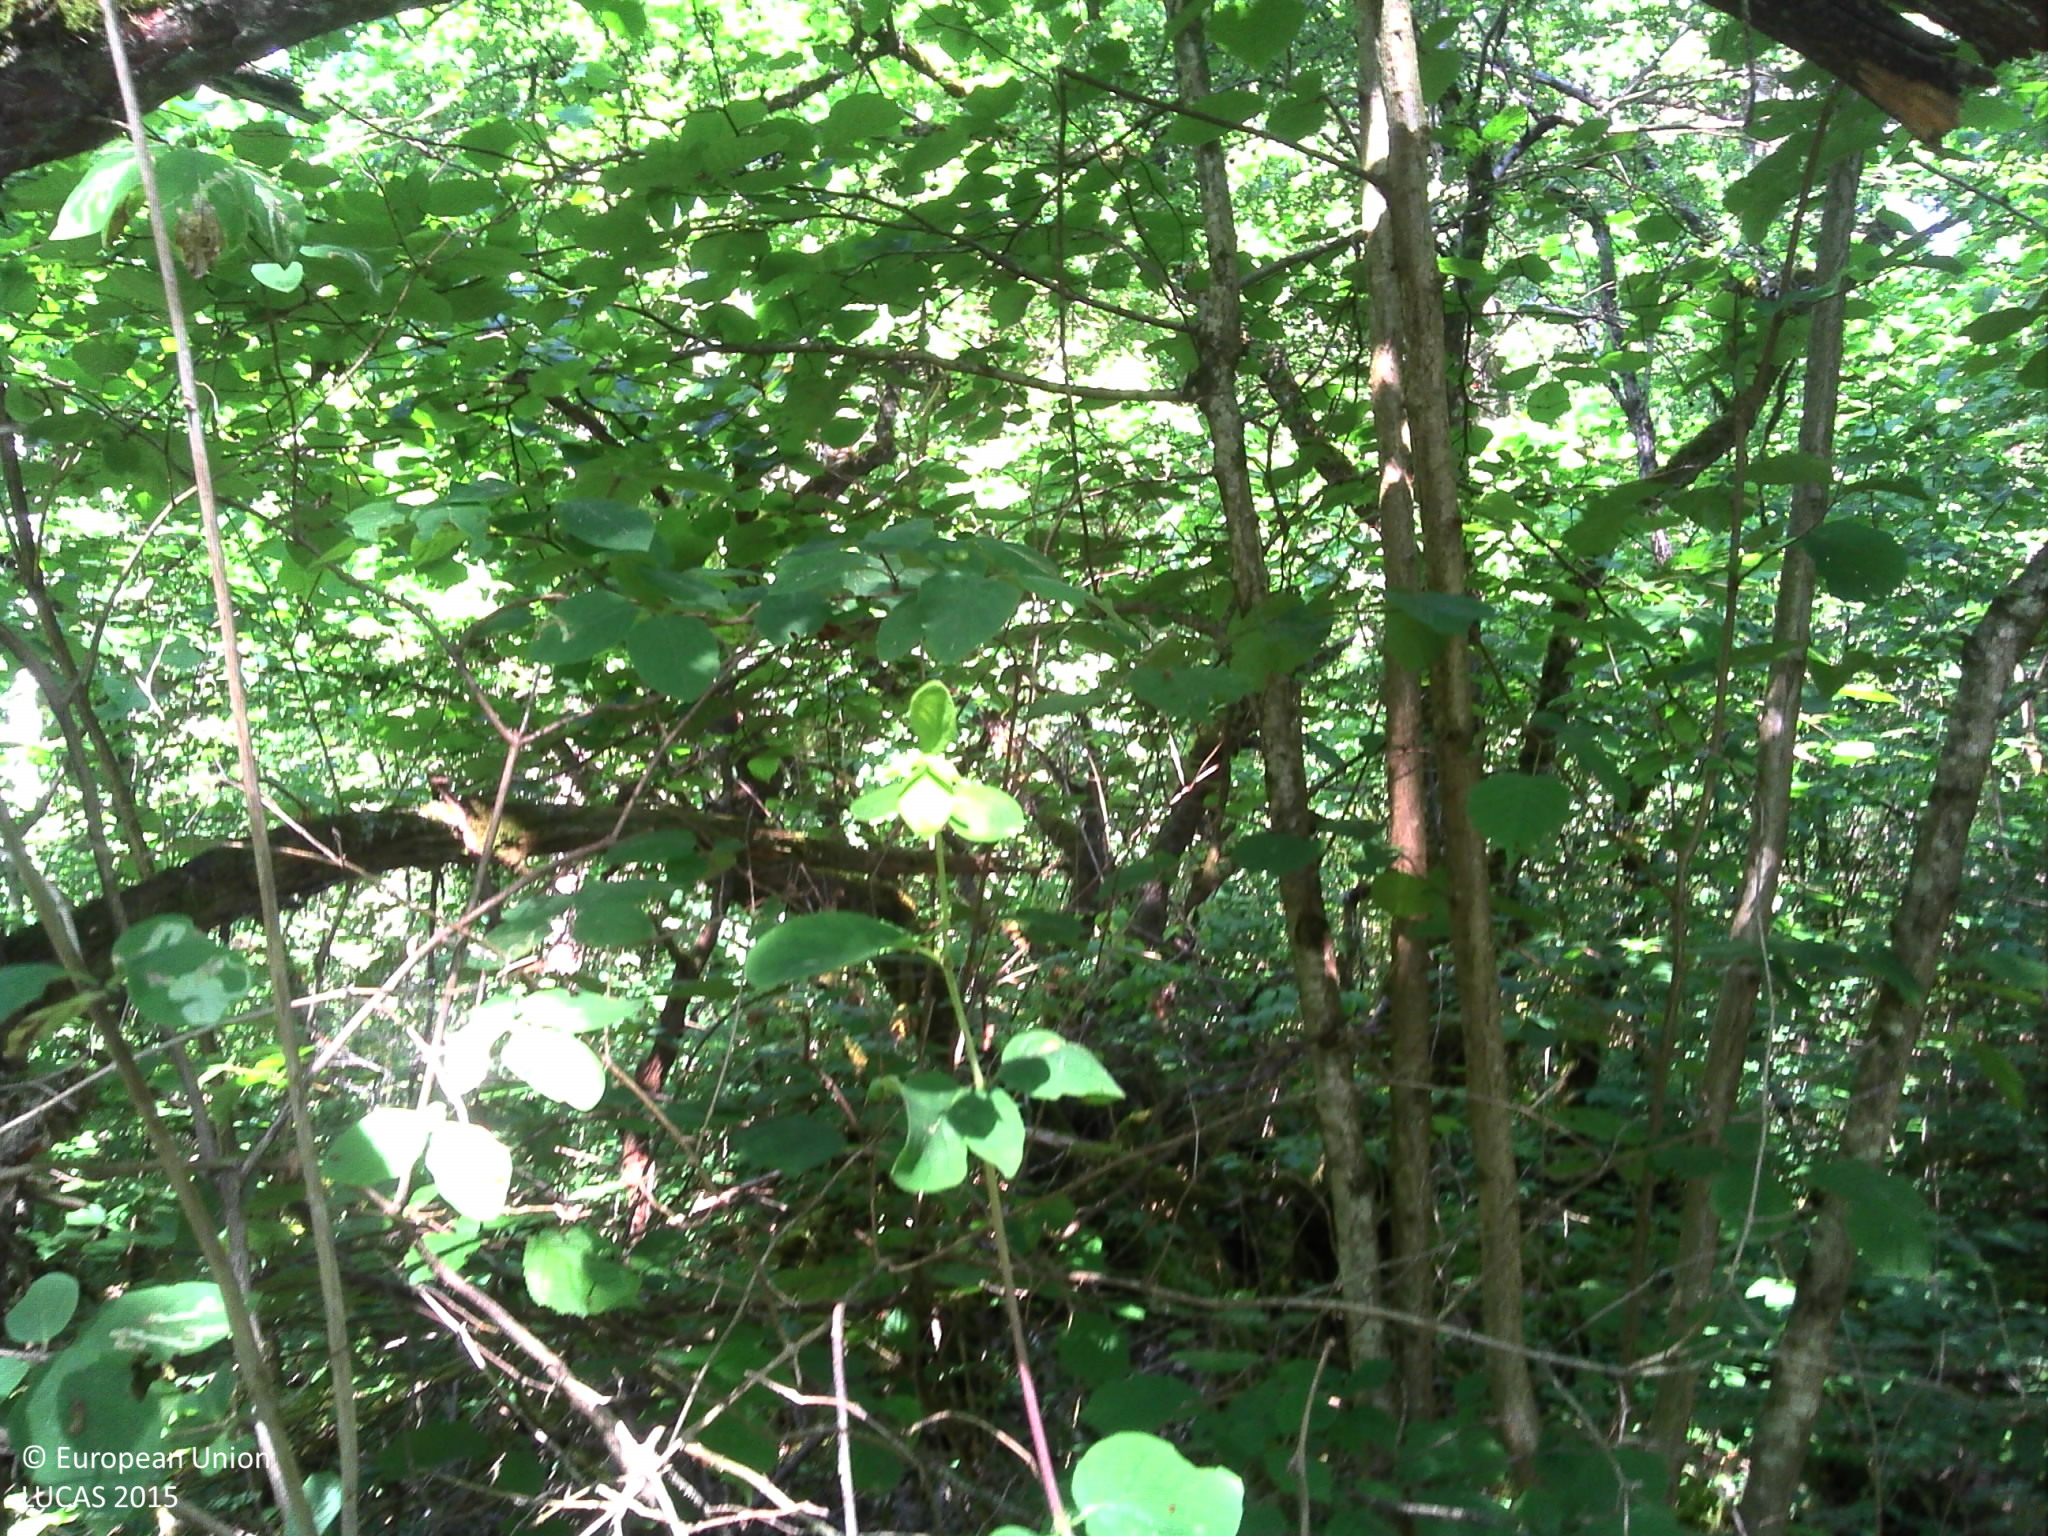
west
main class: Woodland
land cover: Broadleaved woodland
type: acidophilous oak and oak-birch forest
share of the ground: > 75 %
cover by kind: broadleaved forest trees 85 %, coniferous forest trees 5 %, herbaceous plants 5 %, lichens and mosses 5 %
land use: Forestry
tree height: > 5 m
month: June
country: FR
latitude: 48.2030
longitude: 5.0608
